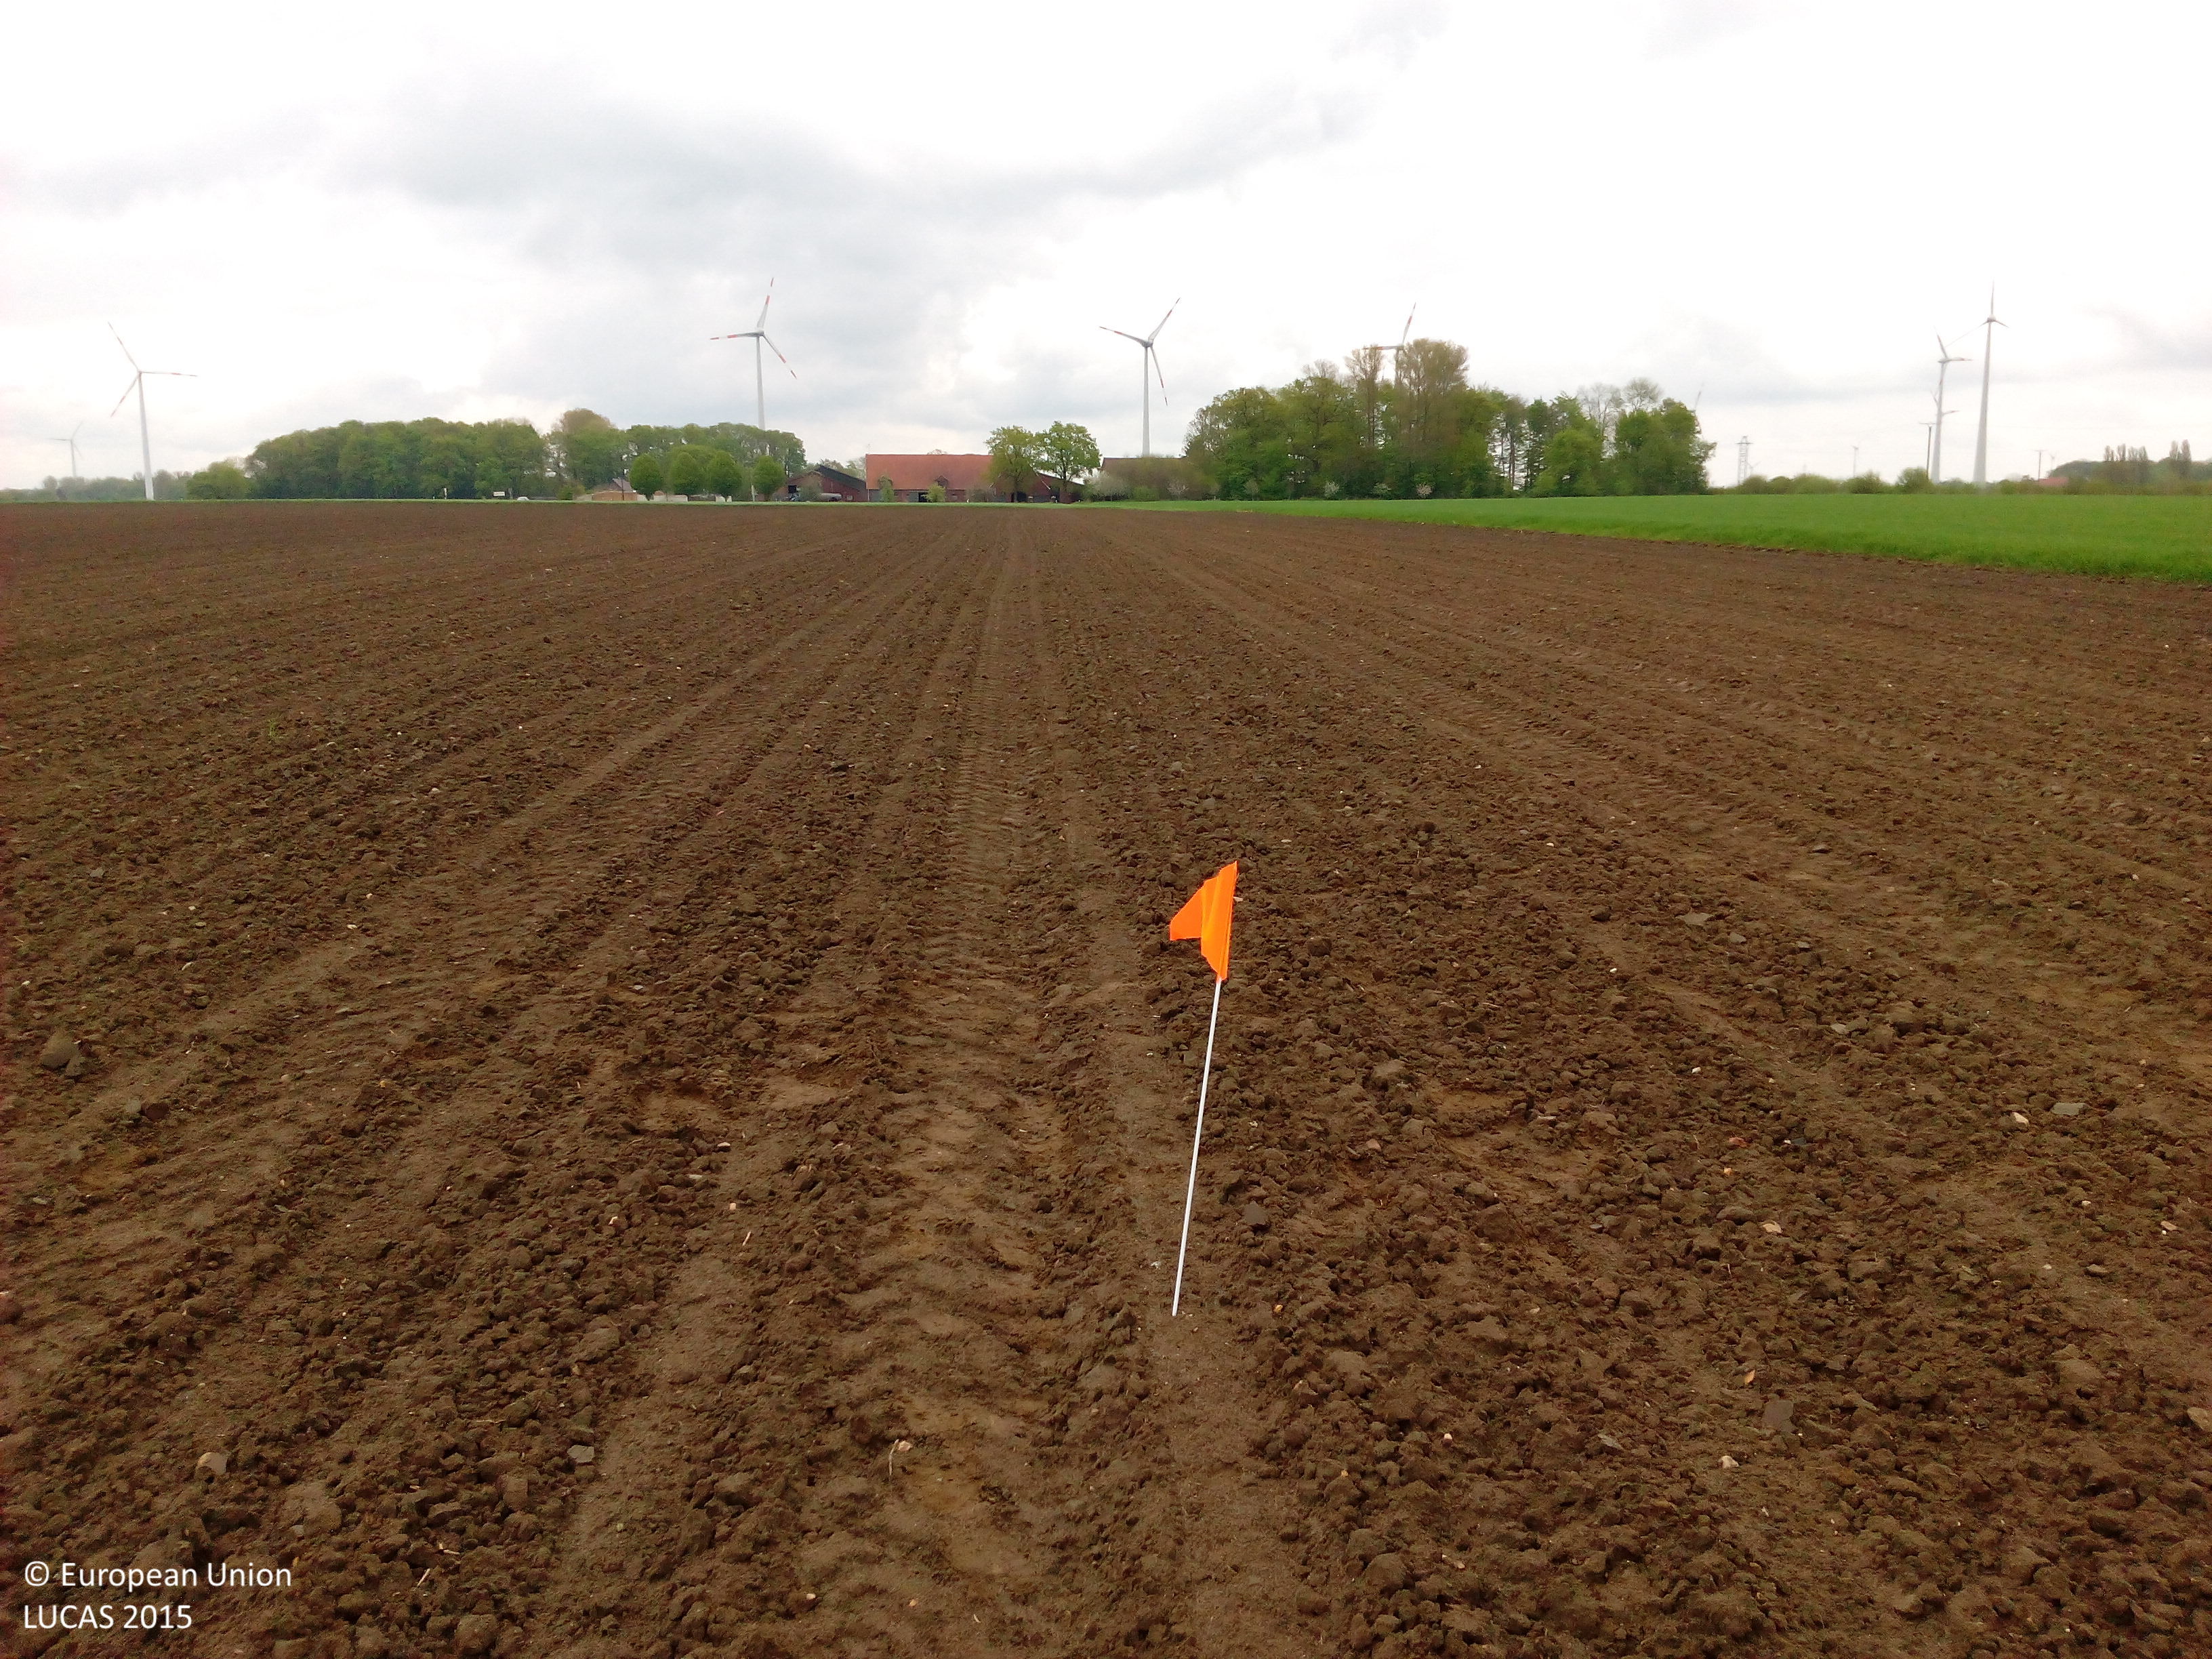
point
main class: Cropland
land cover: Maize
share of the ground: < 10 %
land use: Agriculture (excluding fallow land and kitchen gardens)
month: May
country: DE
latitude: 52.0790
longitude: 7.3884
